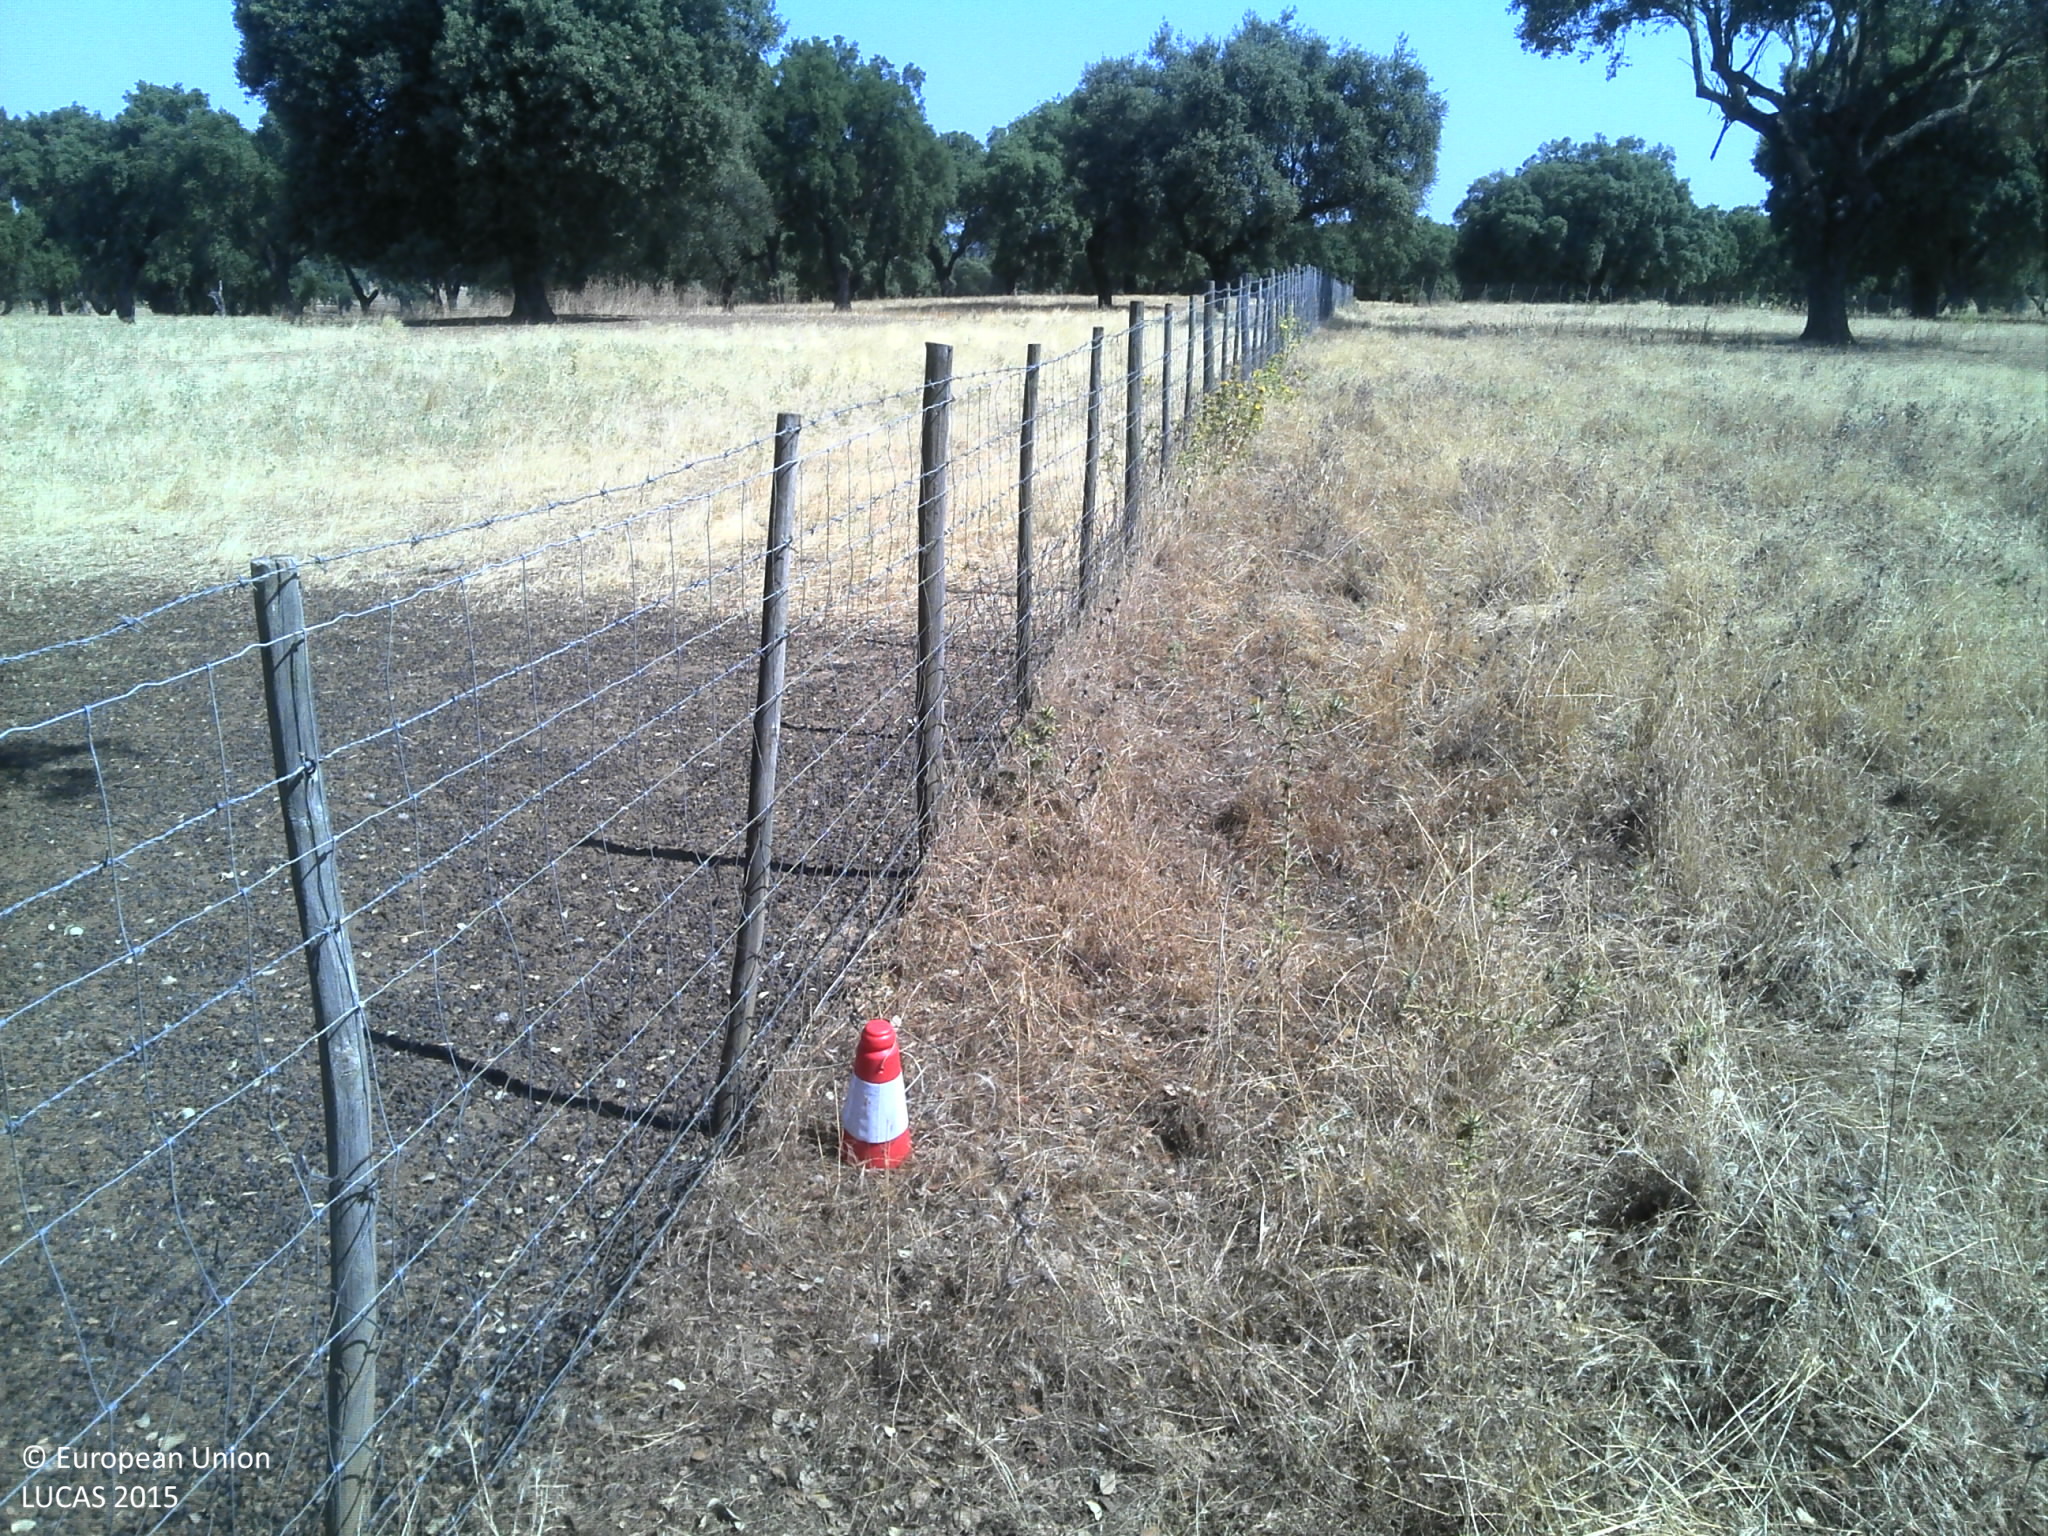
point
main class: Woodland
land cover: Broadleaved woodland
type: broadleaved evergreen forest
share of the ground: 25 - 50 %
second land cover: Grassland without tree/shrub cover
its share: 25 - 50 %
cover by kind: broadleaved forest trees 40 %, herbaceous plants 40 %, unconsolidated bare surface 15 %
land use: Forestry
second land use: Agriculture (excluding fallow land and kitchen gardens)
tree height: > 5 m
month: June
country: PT
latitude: 39.9036
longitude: -7.0624
